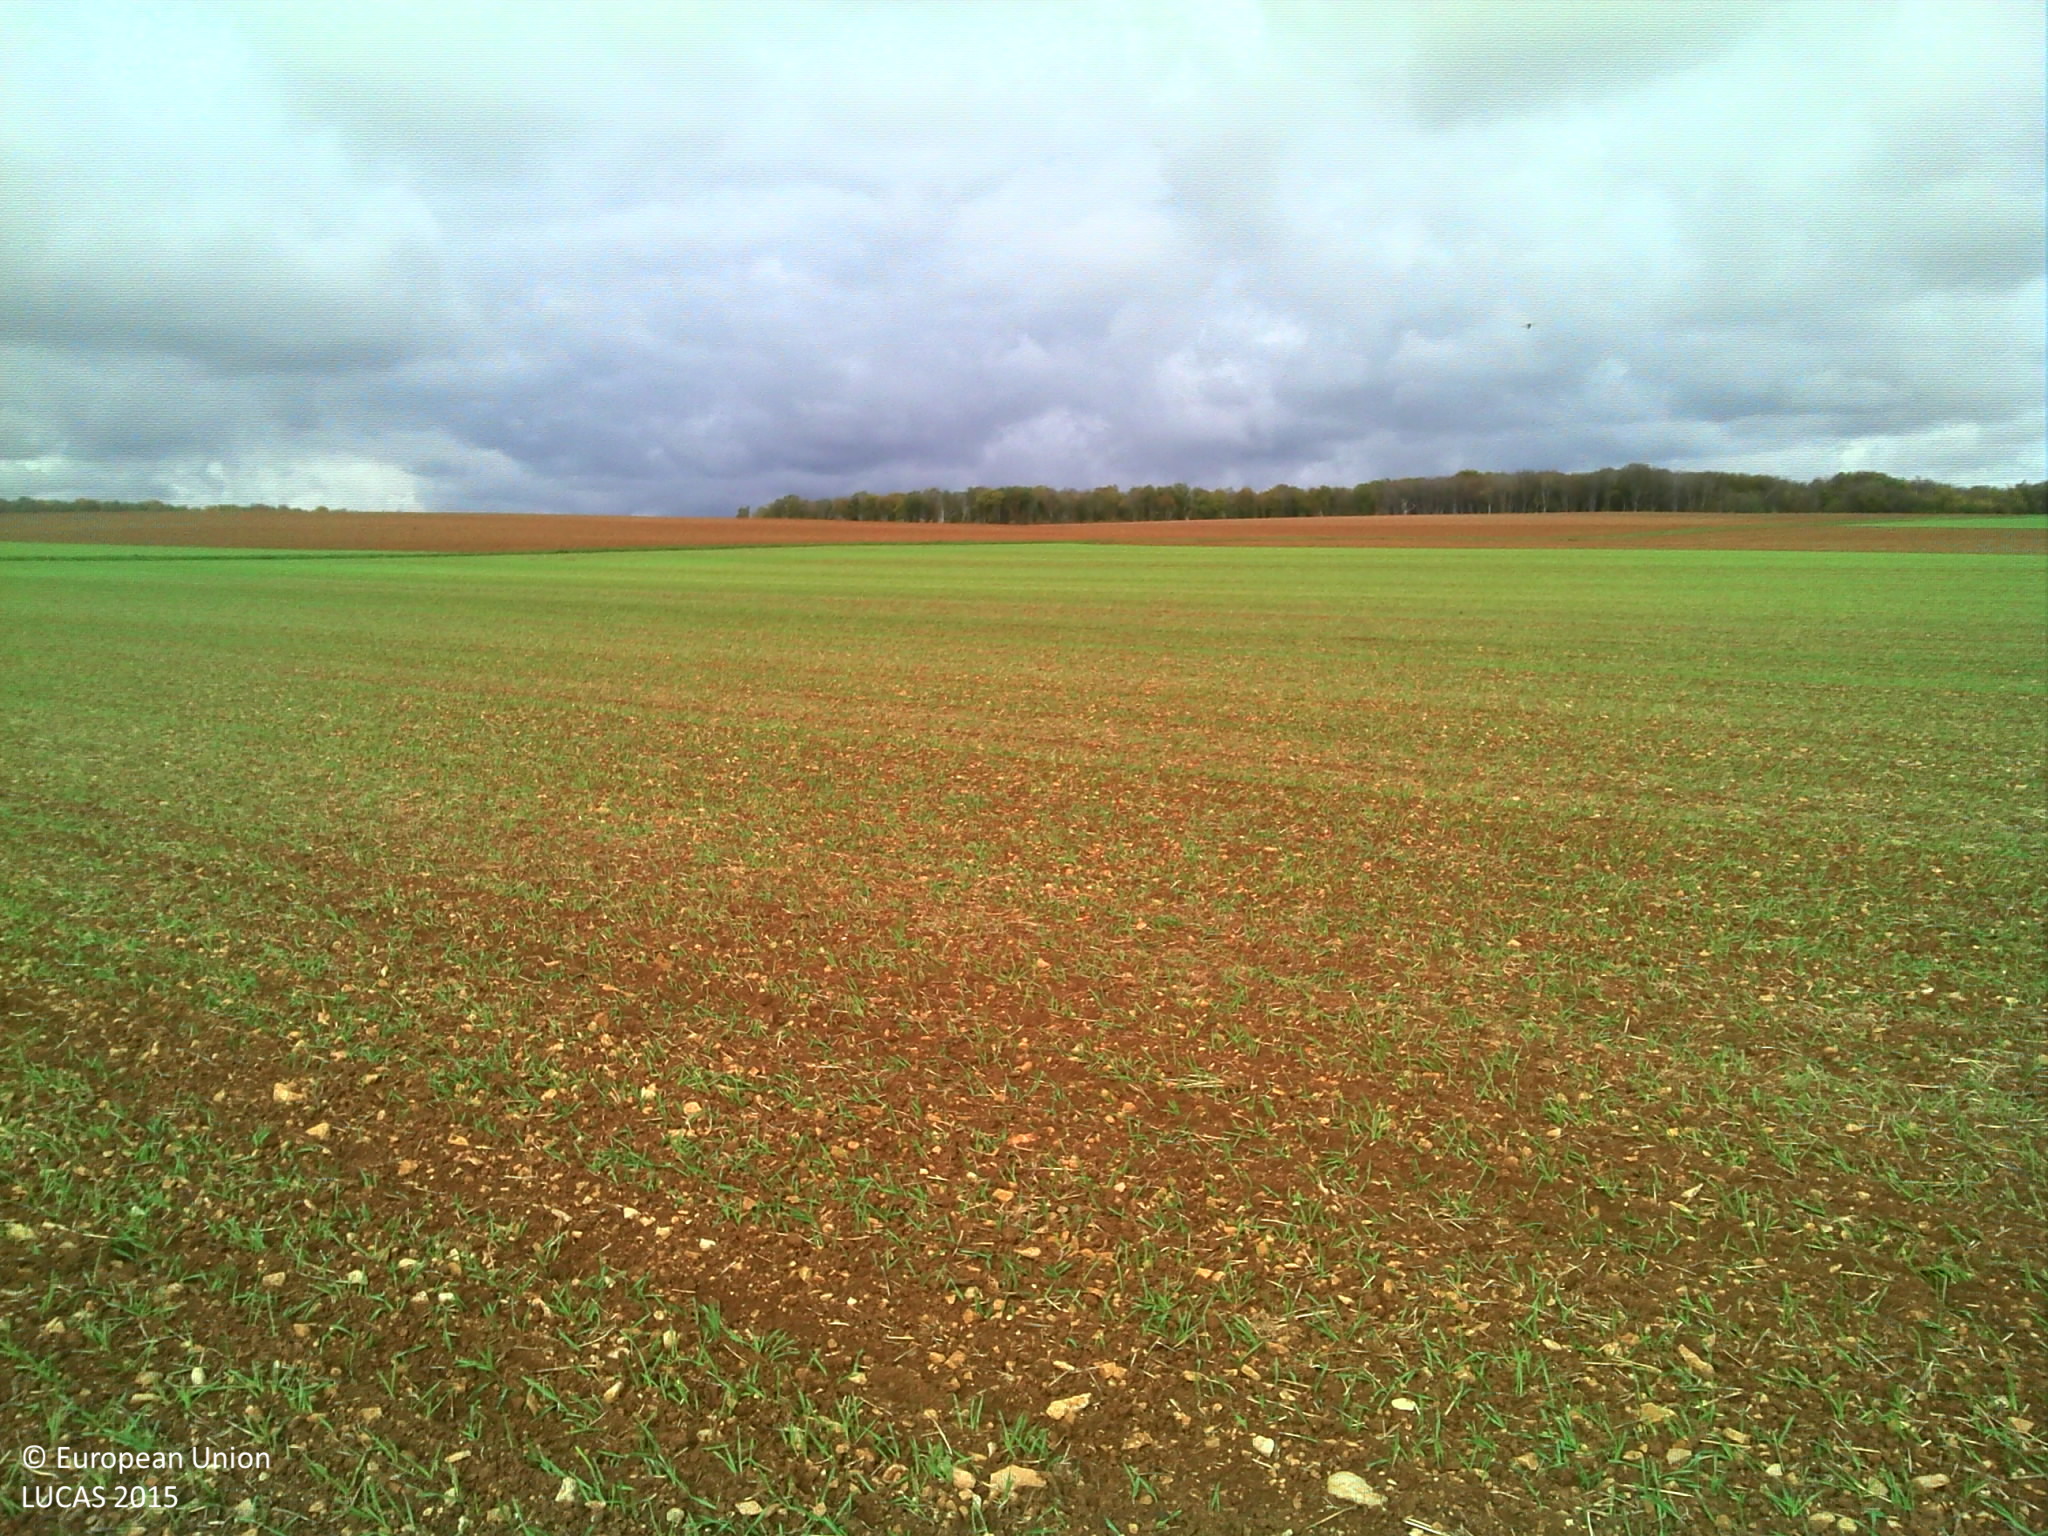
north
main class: Cropland
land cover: Common wheat
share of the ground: 25 - 50 %
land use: Agriculture (excluding fallow land and kitchen gardens)
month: October
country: FR
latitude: 47.3842
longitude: 4.9003
